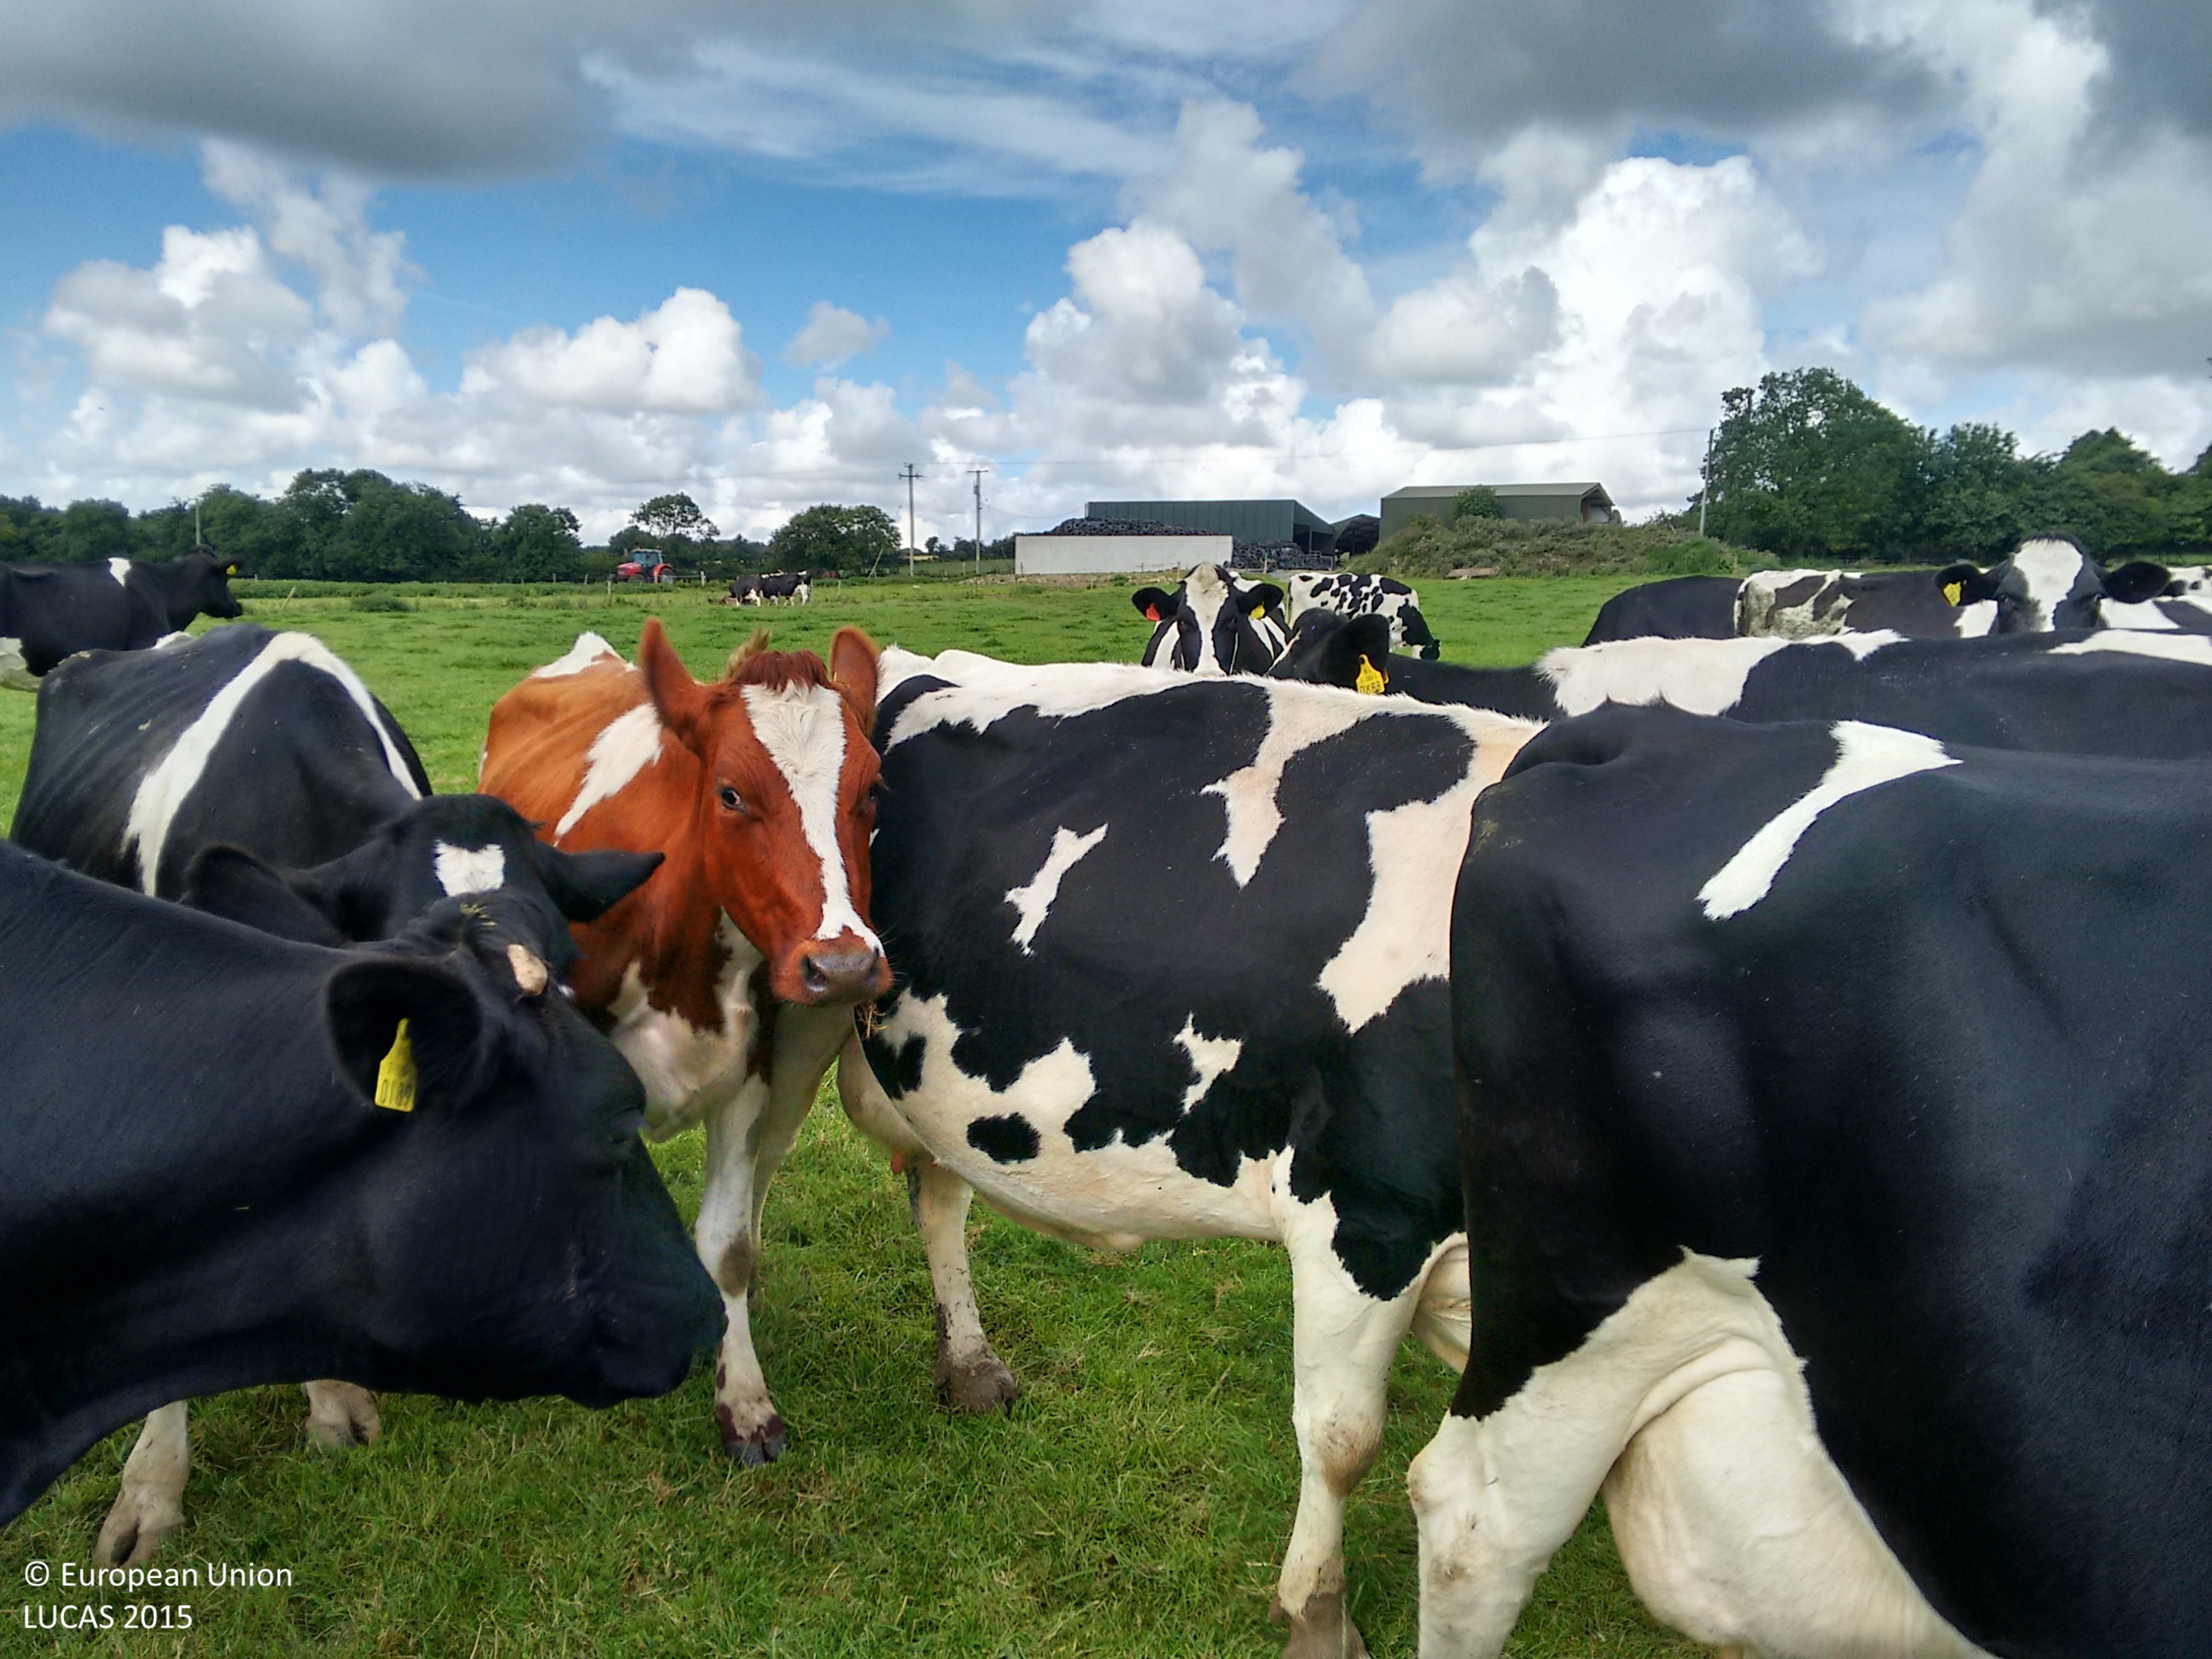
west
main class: Grassland
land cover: Grassland without tree/shrub cover
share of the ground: > 75 %
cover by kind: herbaceous plants 100 %
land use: Agriculture (excluding fallow land and kitchen gardens)
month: August
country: IE
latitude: 52.5574
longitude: -6.3332
